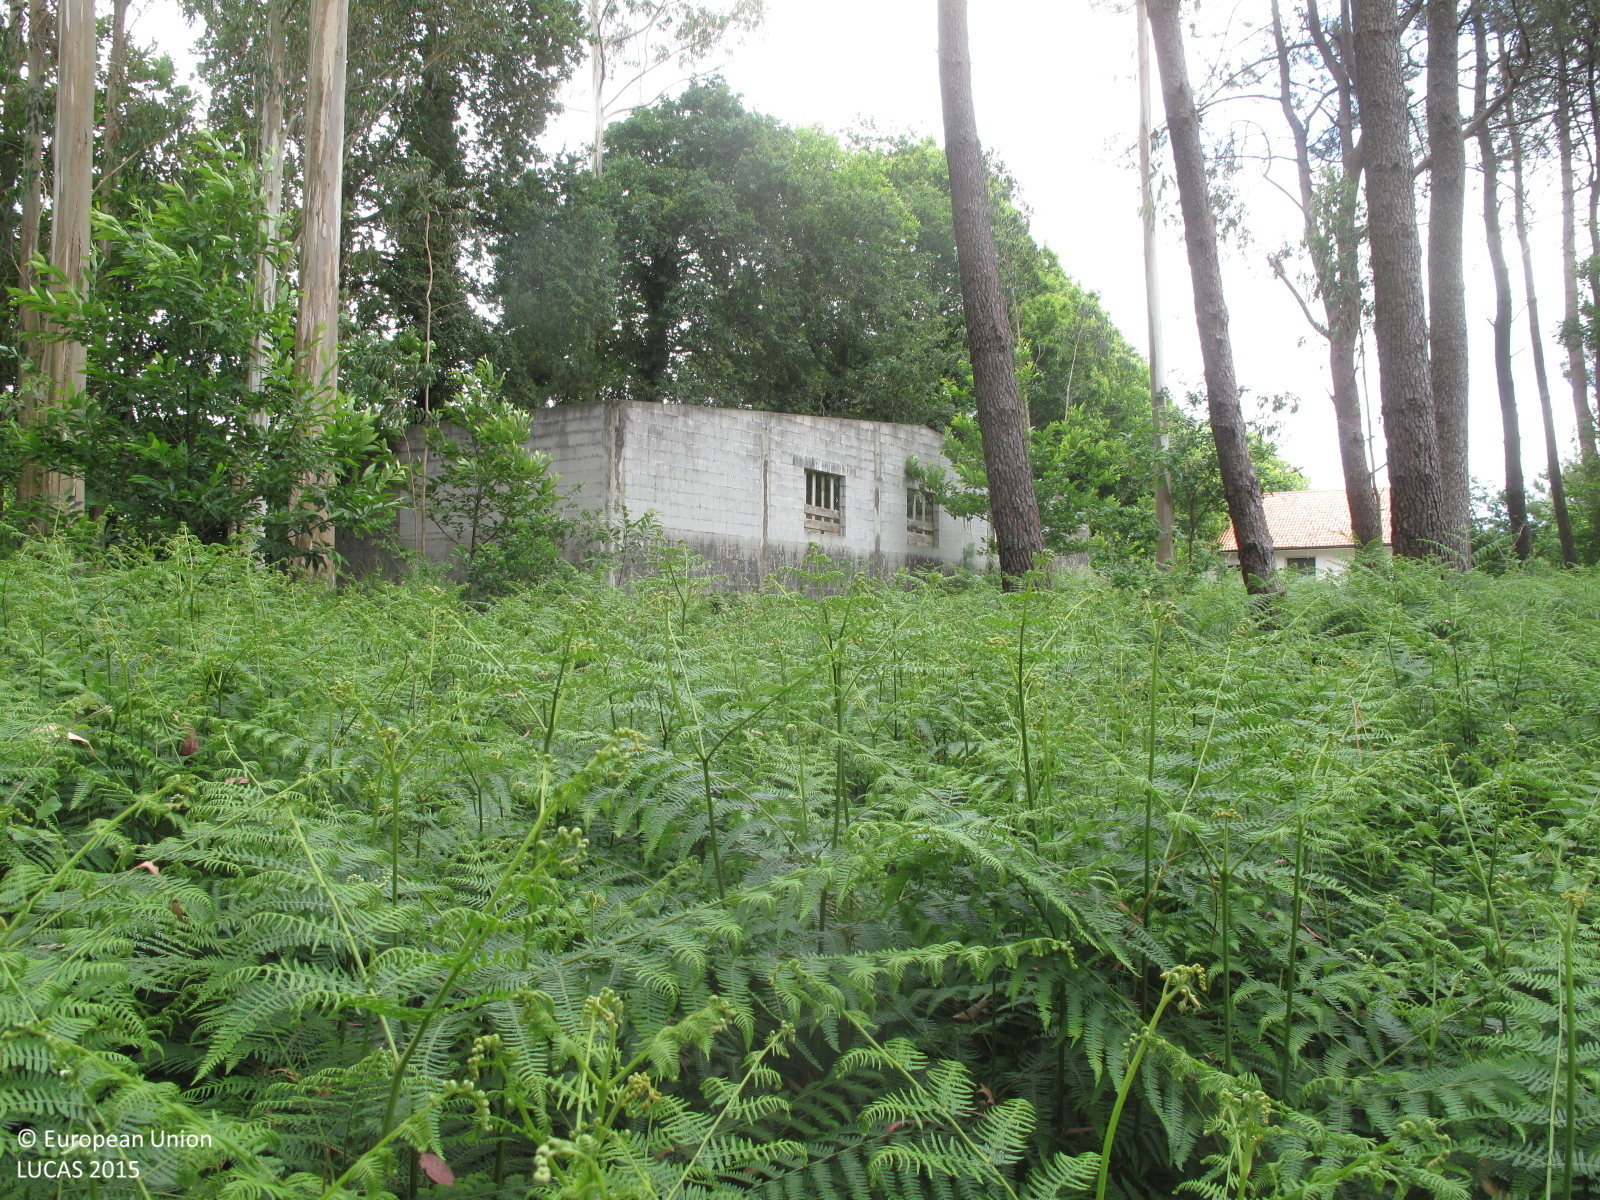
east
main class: Woodland
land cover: Other mixed woodland
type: exotic forest
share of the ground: > 75 %
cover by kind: broadleaved forest trees 40 %, coniferous forest trees 30 %, herbaceous plants 30 %
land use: Forestry
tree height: > 5 m
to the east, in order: Other mixed woodland; Artificial constructions in urban areas; Broadleaved woodland; Grassland without tree/shrub cover; Fences; Shruby margins; Grassland without tree/shrub cover; Electric lines; Grassland without tree/shrub cover; Potatoes; Spontaneously vegetated surfaces; Tracks; Electric lines; Paved roads, cycling and walking lanes; Electric lines; Grassland without tree/shrub cover; Electric lines; Grassland without tree/shrub cover
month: June
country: ES
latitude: 43.0506
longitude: -8.5343
